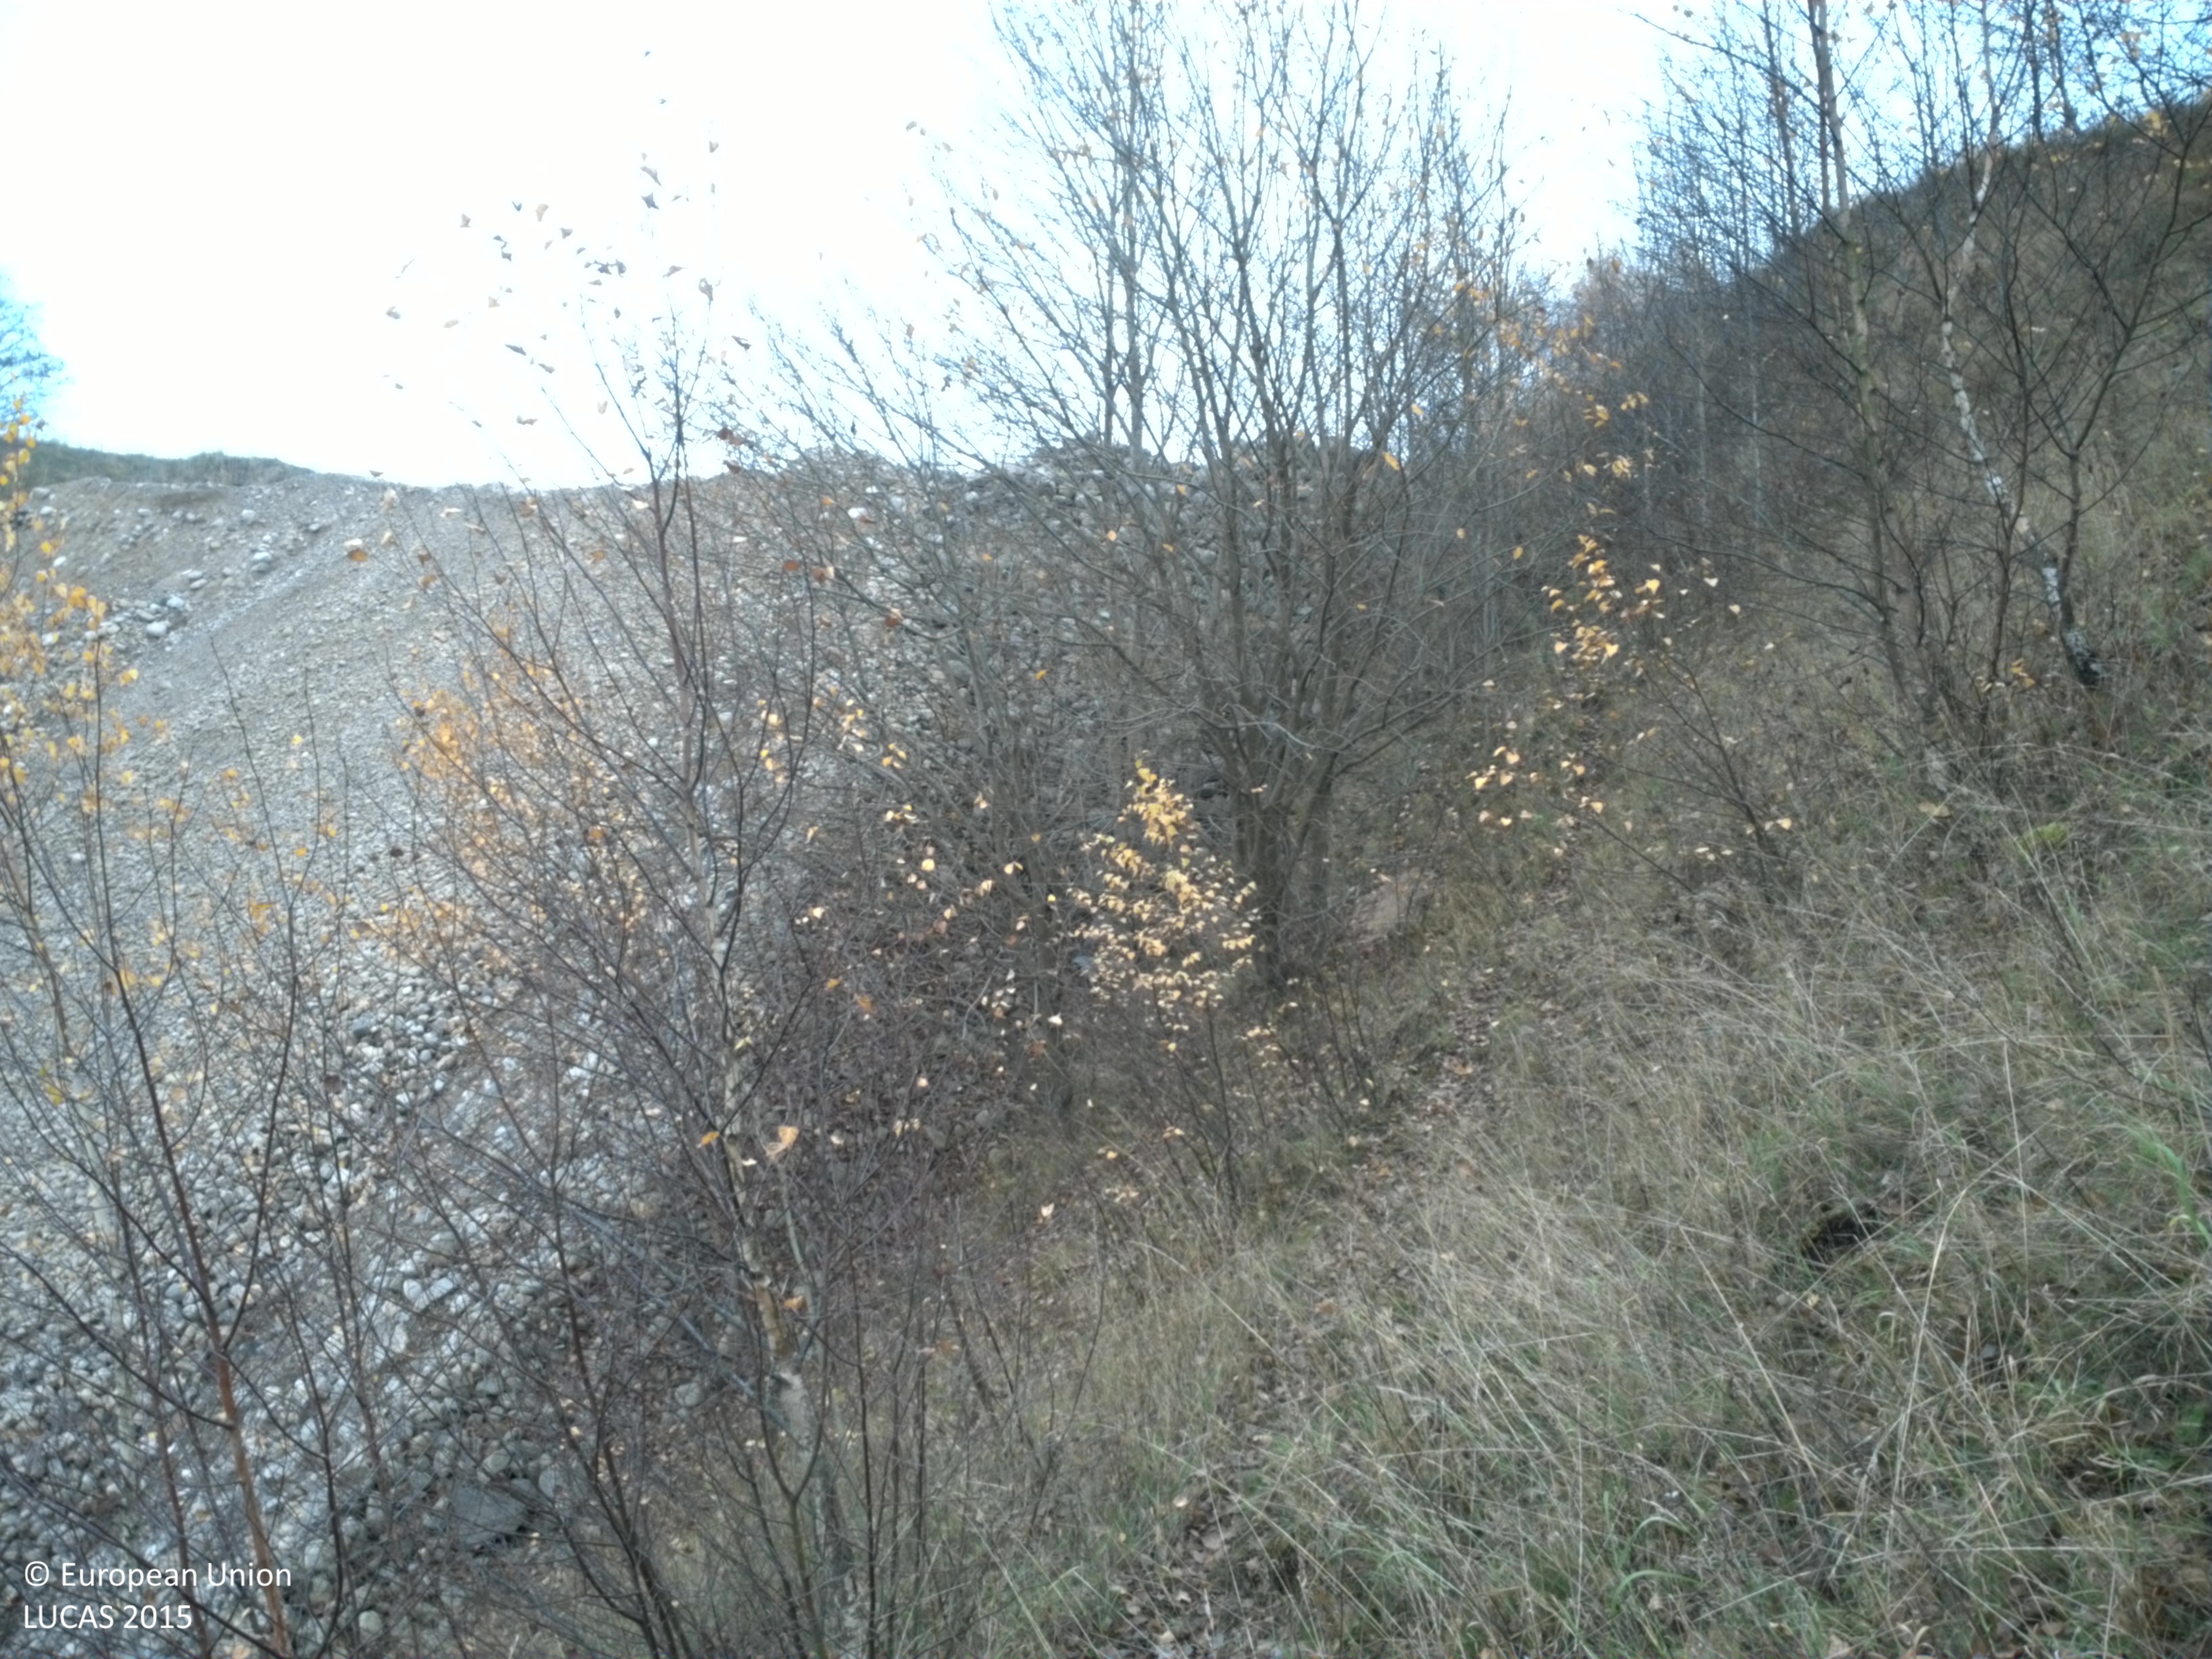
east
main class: Woodland
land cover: Broadleaved woodland
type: hemiboreal forest and nemoral coniferous forest and mixed broadleaved-coniferous forest
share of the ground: 10 - 25 %
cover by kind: herbaceous plants 80 %, broadleaved forest trees 20 %
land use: Mining and quarrying
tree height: < 5 m
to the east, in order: Broadleaved woodland; Rocks and stones; Tracks; Spontaneously vegetated surfaces; Tracks; Grass margins; Ditches and canals; Temporary grasslands
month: November
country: SE
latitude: 56.1151
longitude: 13.0693
